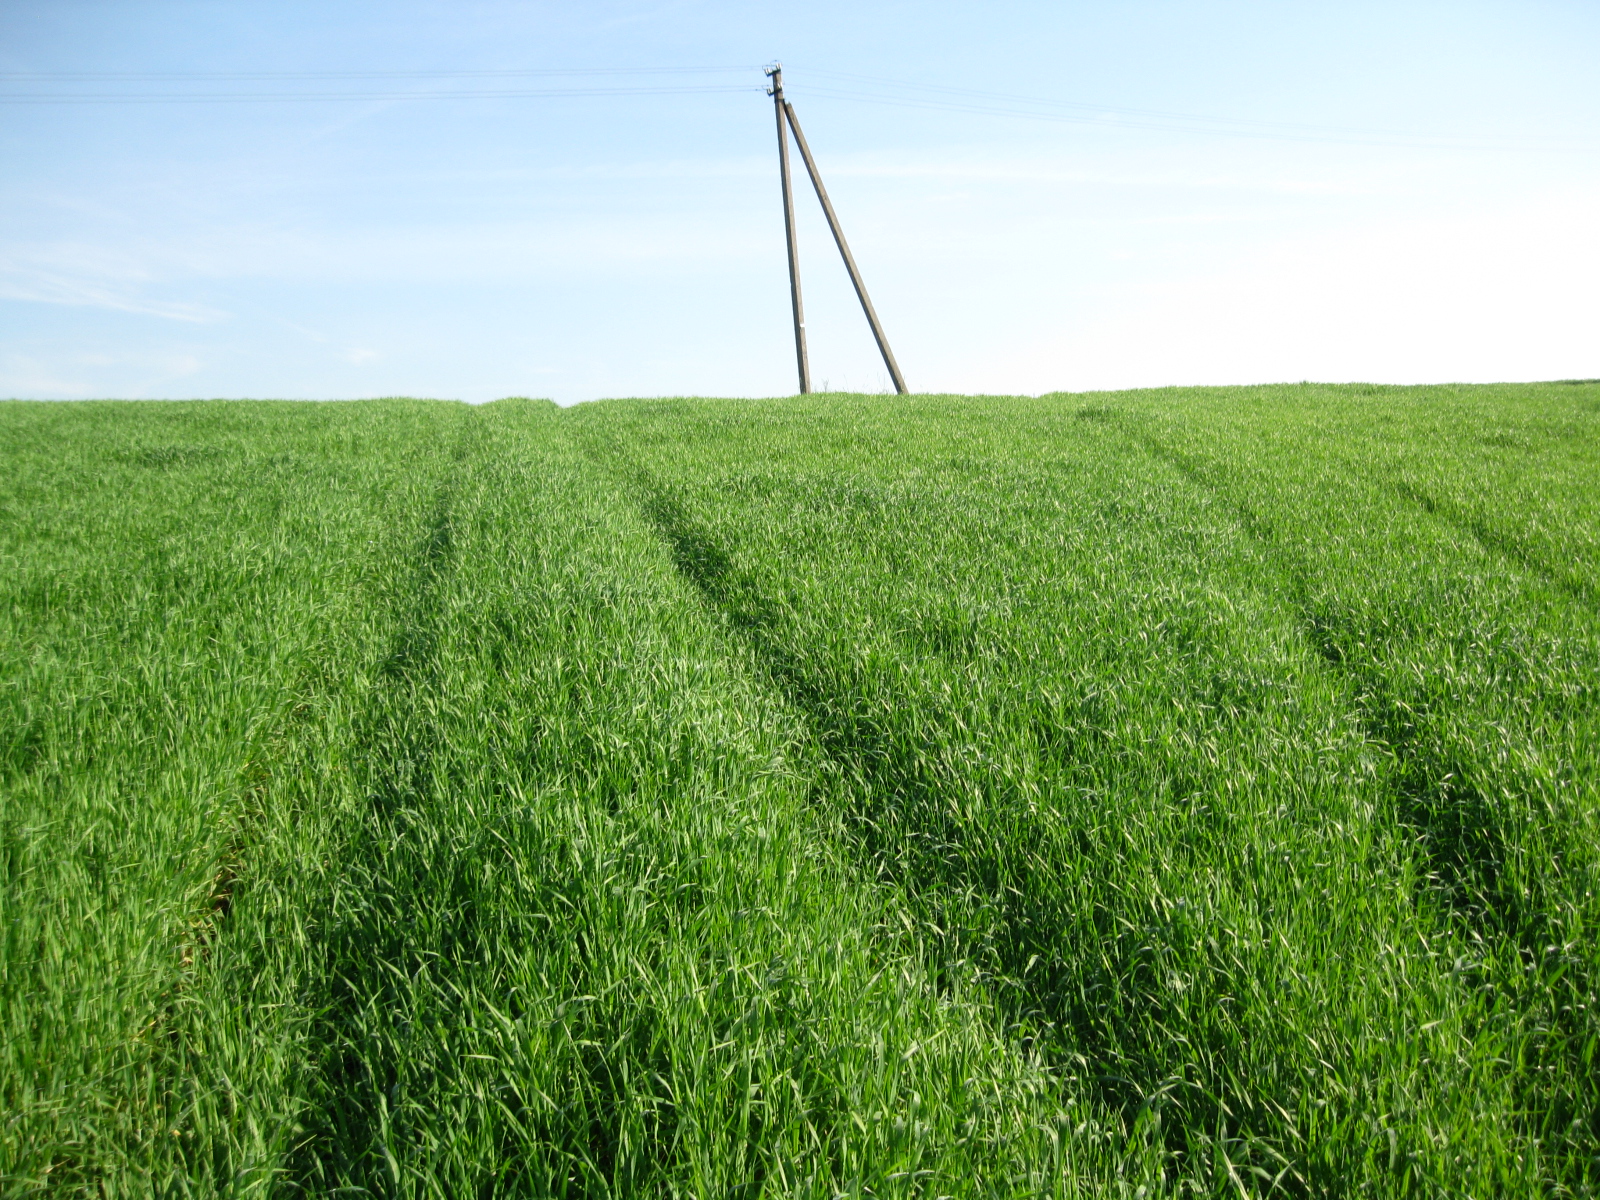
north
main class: Cropland
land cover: Barley
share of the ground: > 75 %
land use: Agriculture (excluding fallow land and kitchen gardens)
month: June
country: LT
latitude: 55.4169
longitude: 23.6523
